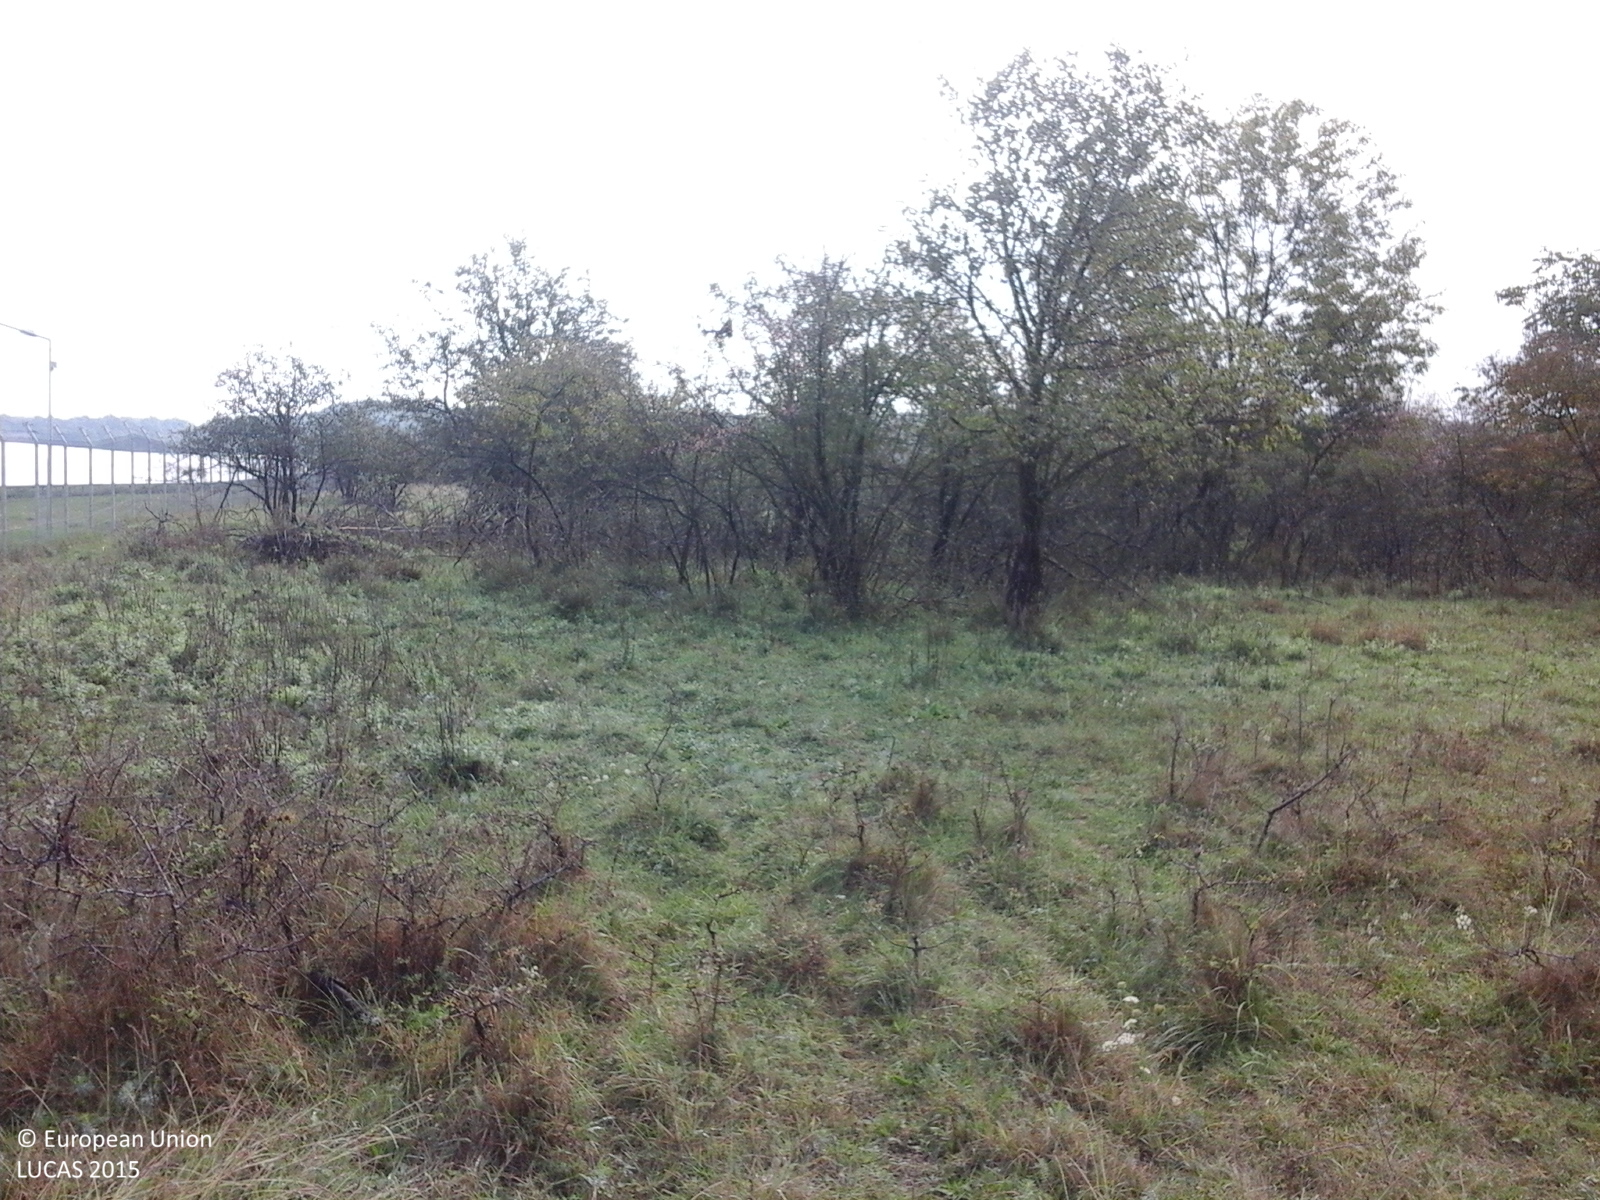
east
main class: Grassland
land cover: Grassland with sparse tree/shrub cover
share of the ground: > 75 %
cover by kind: herbaceous plants 85 %, shrubs 10 %, broadleaved forest trees 5 %
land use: Fallow land
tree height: < 5 m
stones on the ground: < 10 %
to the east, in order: Grassland with sparse tree/shrub cover; Shrubland without tree cover; Grassland without tree/shrub cover; Shrubland without tree cover; Spontaneously vegetated surfaces
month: September
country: RO
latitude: 45.0792
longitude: 23.1494
